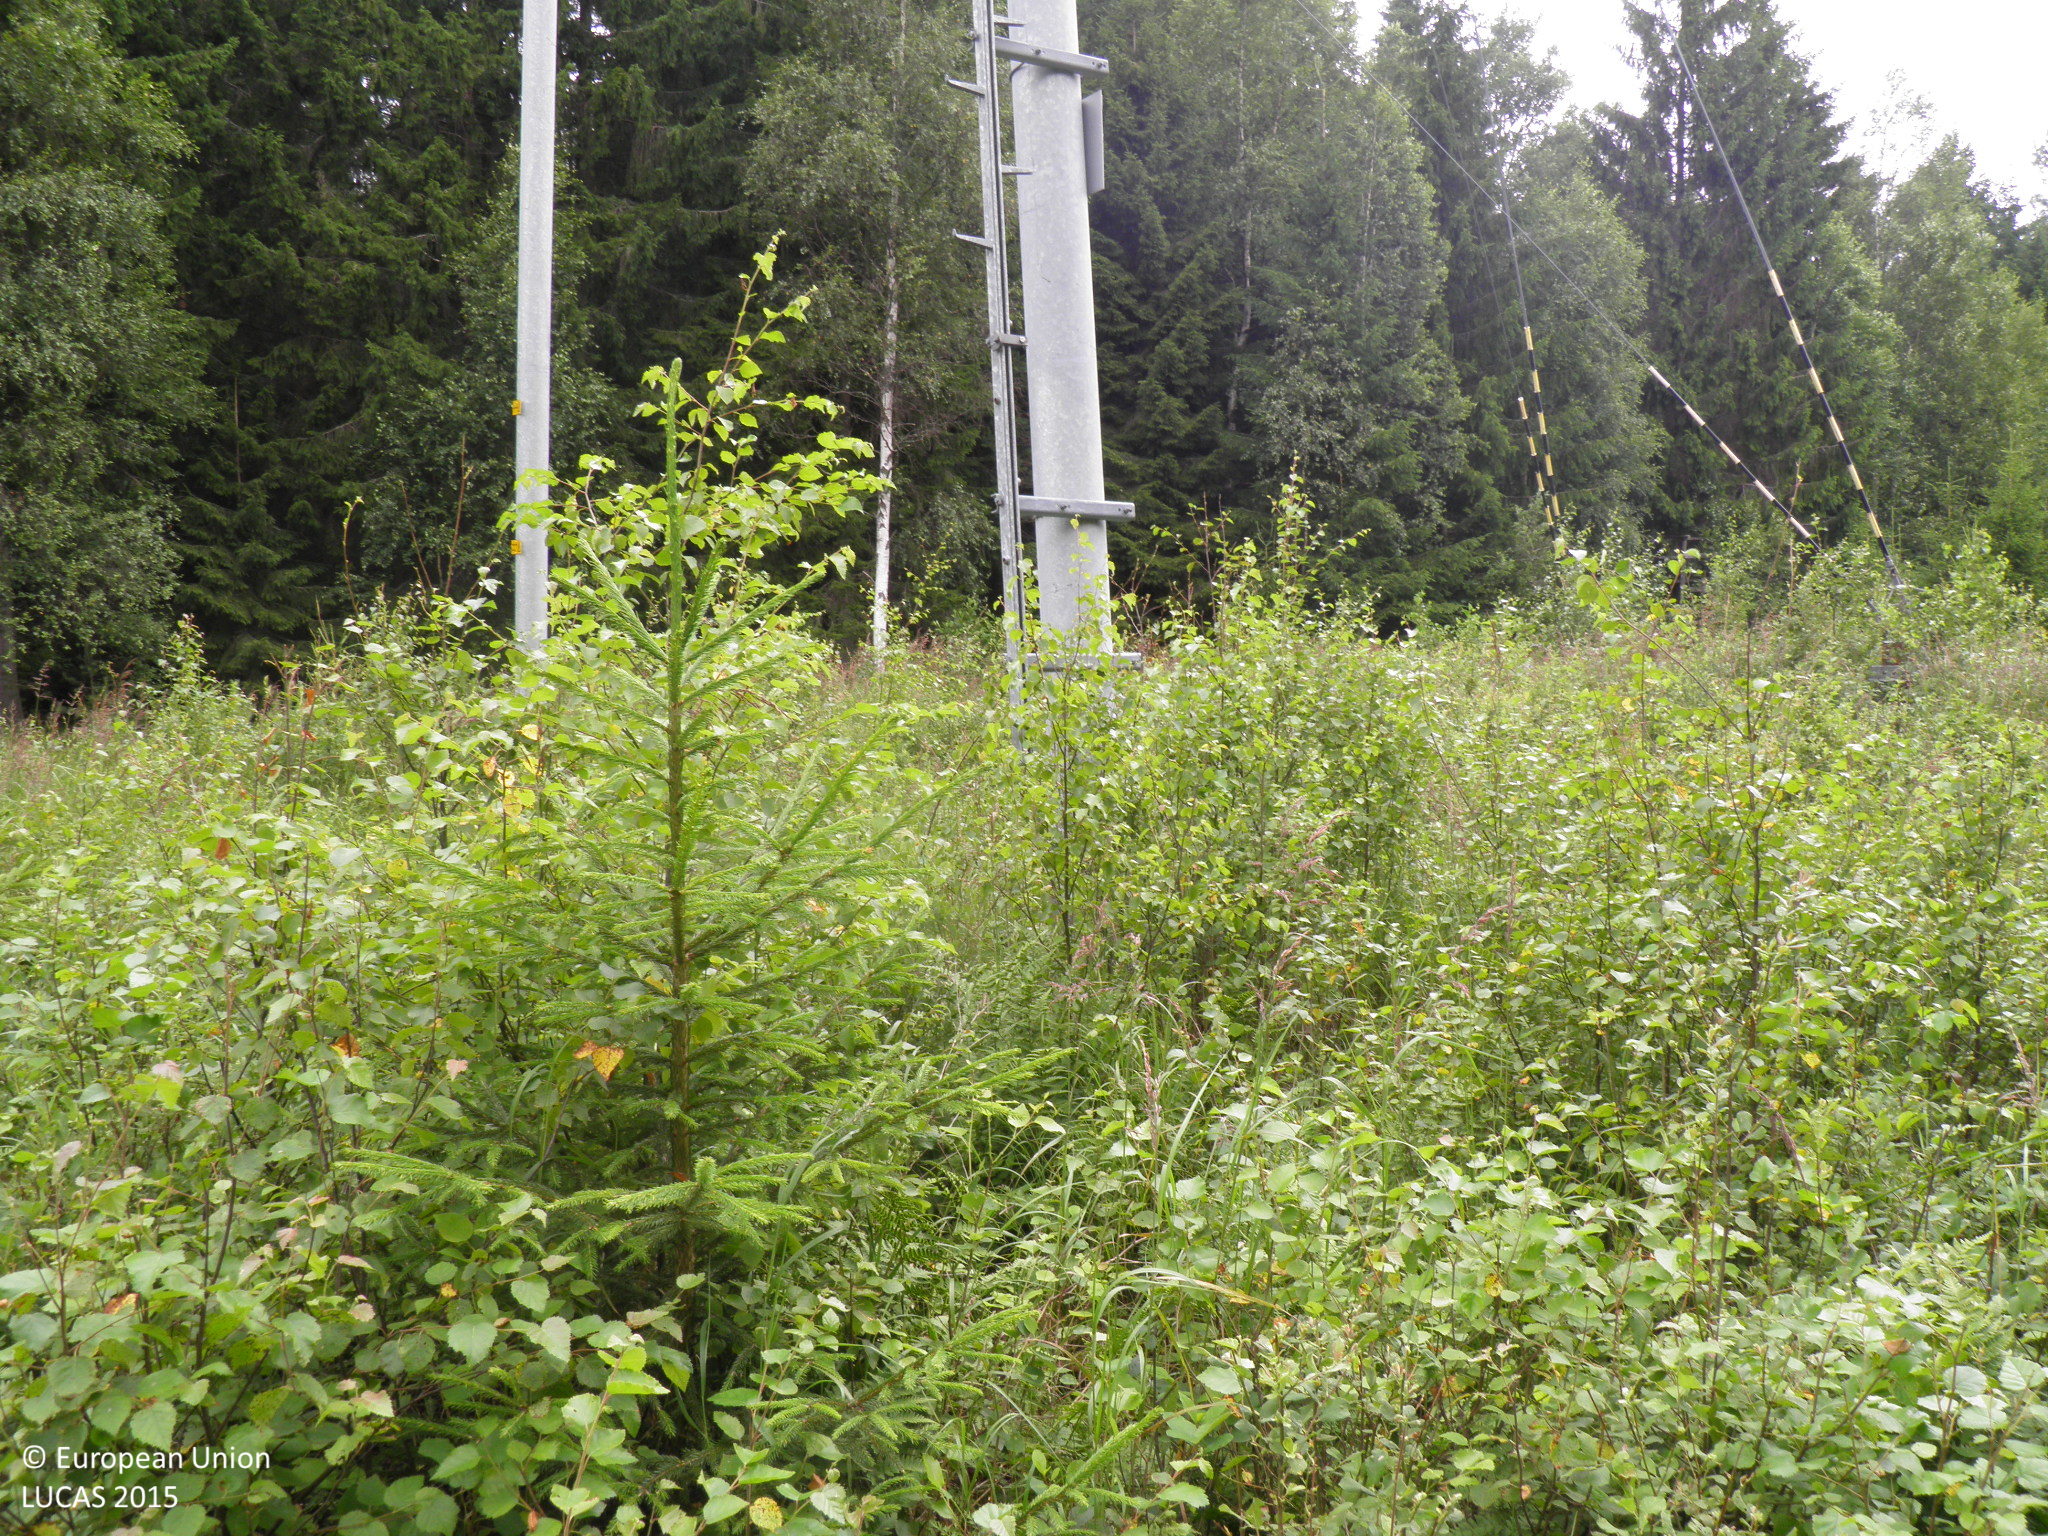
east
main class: Artificial land
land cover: Other artificial areas
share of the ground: > 75 %
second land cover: Shrubland with sparse tree cover
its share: > 75 %
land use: Electricity, gas and thermal power distribution
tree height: < 5 m
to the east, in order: Artificial constructions in urban areas; Shrubland with sparse tree cover; Electric lines; Shrubland with sparse tree cover; Broadleaved woodland; Pine dominated mixed woodland; Ditches and canals; Pine dominated mixed woodland; Ditches and canals; Pine dominated mixed woodland; Broadleaved woodland; Ditches and canals; Broadleaved woodland; Rock outcrops; Pine dominated mixed woodland; Electric lines; Grass margins; Paved roads, cycling and walking lanes
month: July
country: FI
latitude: 60.2157
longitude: 22.8004
